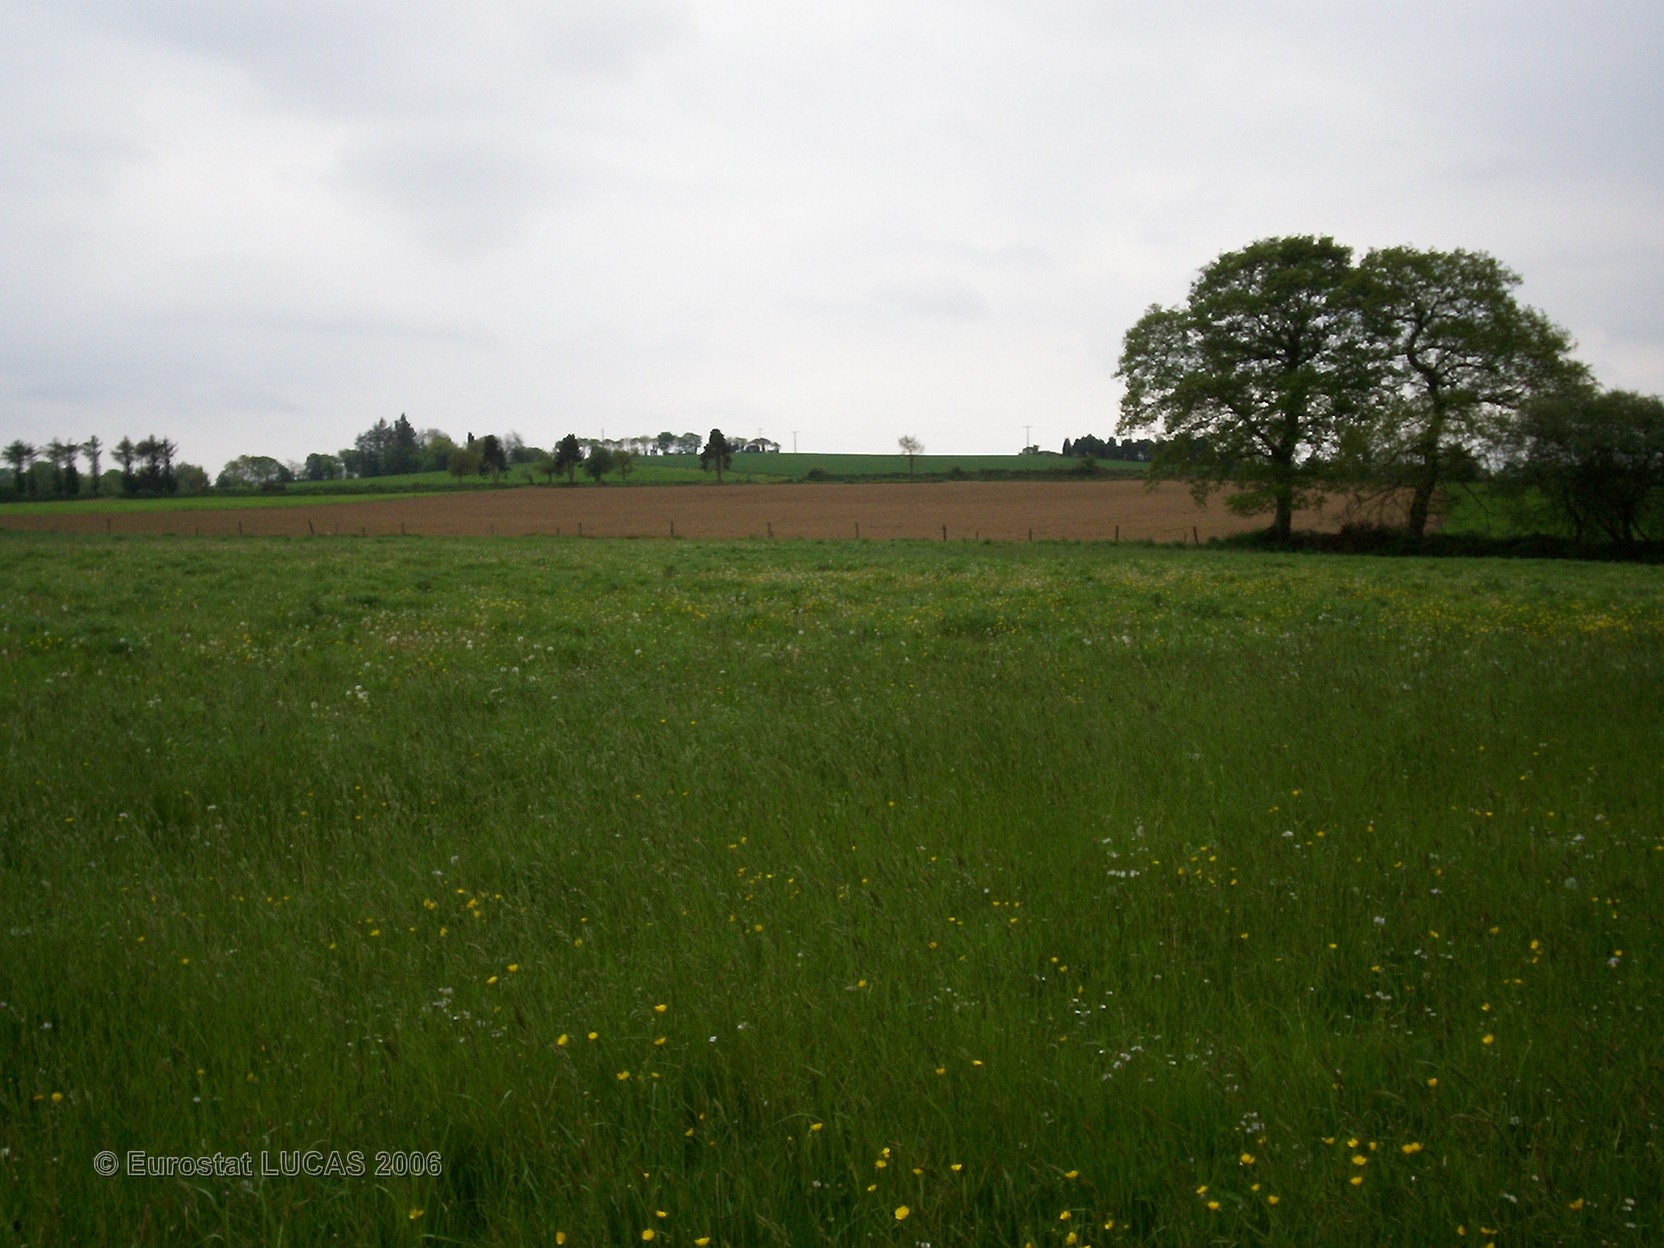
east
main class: Grassland
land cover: Grassland without tree/shrub cover
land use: Agriculture (excluding fallow land and kitchen gardens)
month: May
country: FR
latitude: 48.2784
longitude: -3.6777
